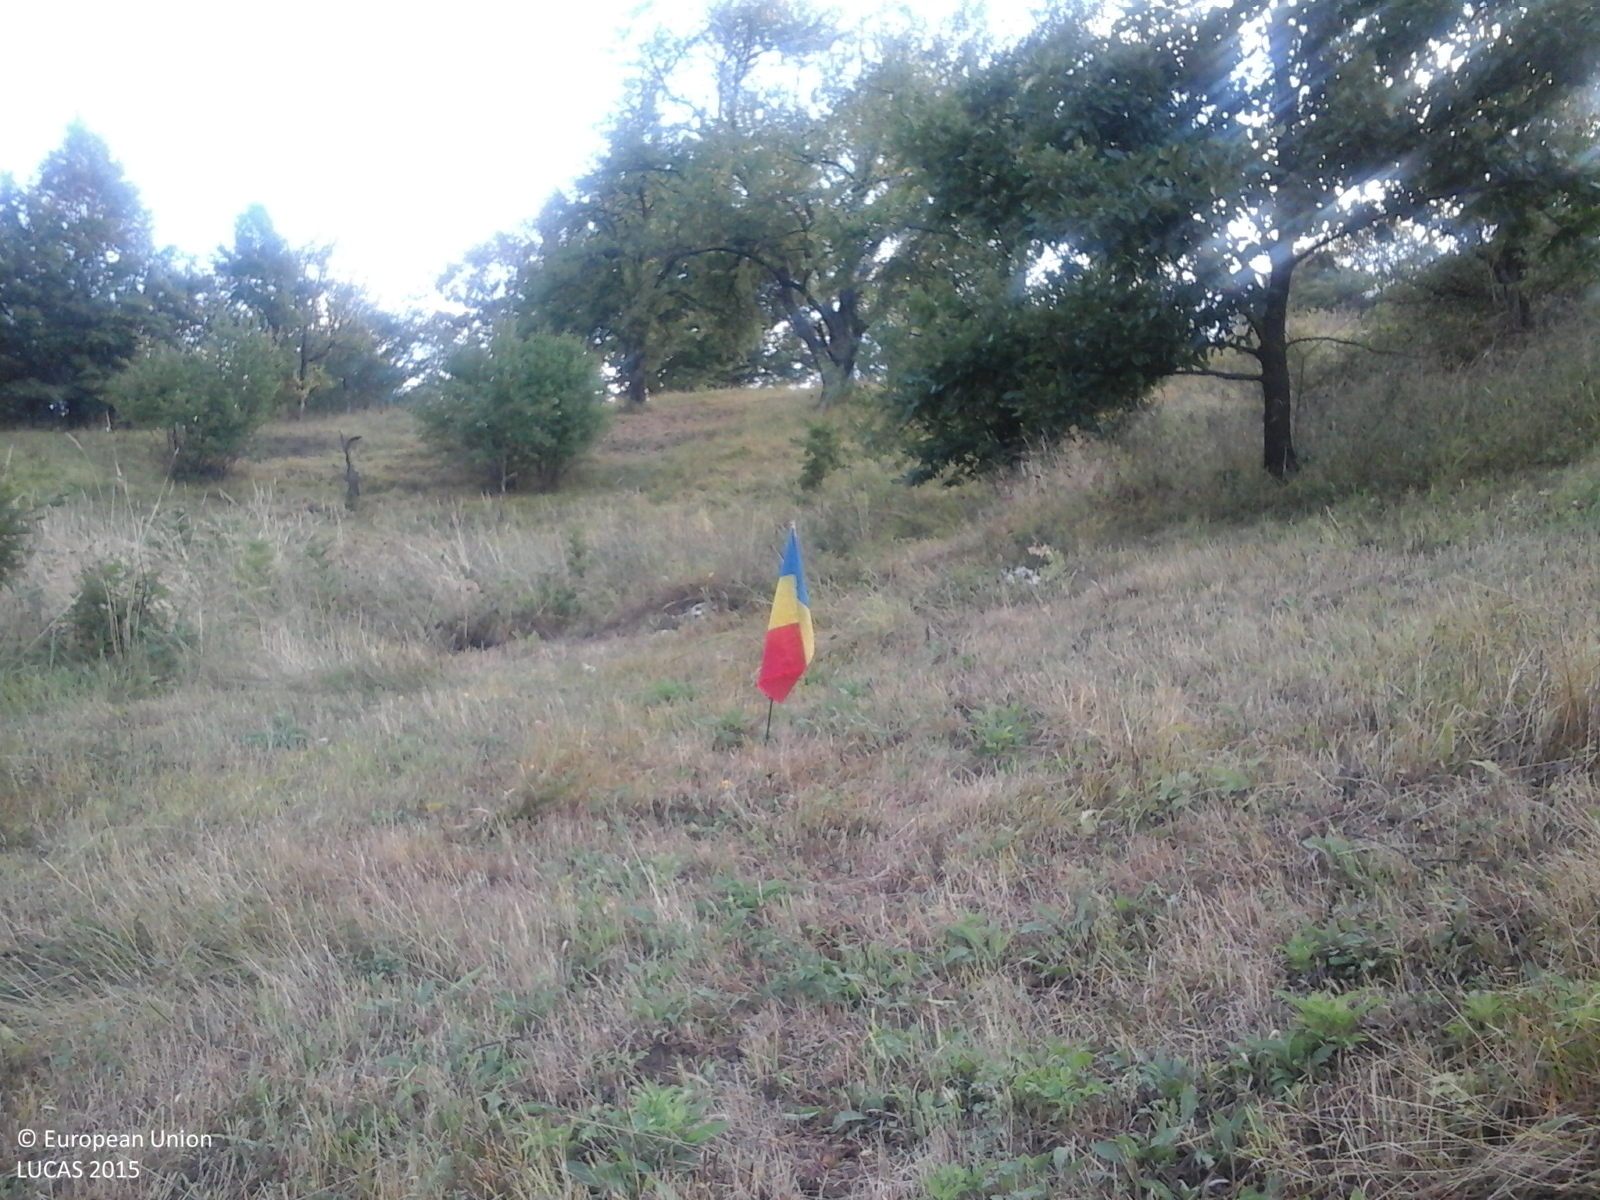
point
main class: Grassland
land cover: Grassland without tree/shrub cover
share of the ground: > 75 %
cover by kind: herbaceous plants 100 %
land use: Agriculture (excluding fallow land and kitchen gardens)
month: August
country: RO
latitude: 44.8419
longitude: 21.7844
